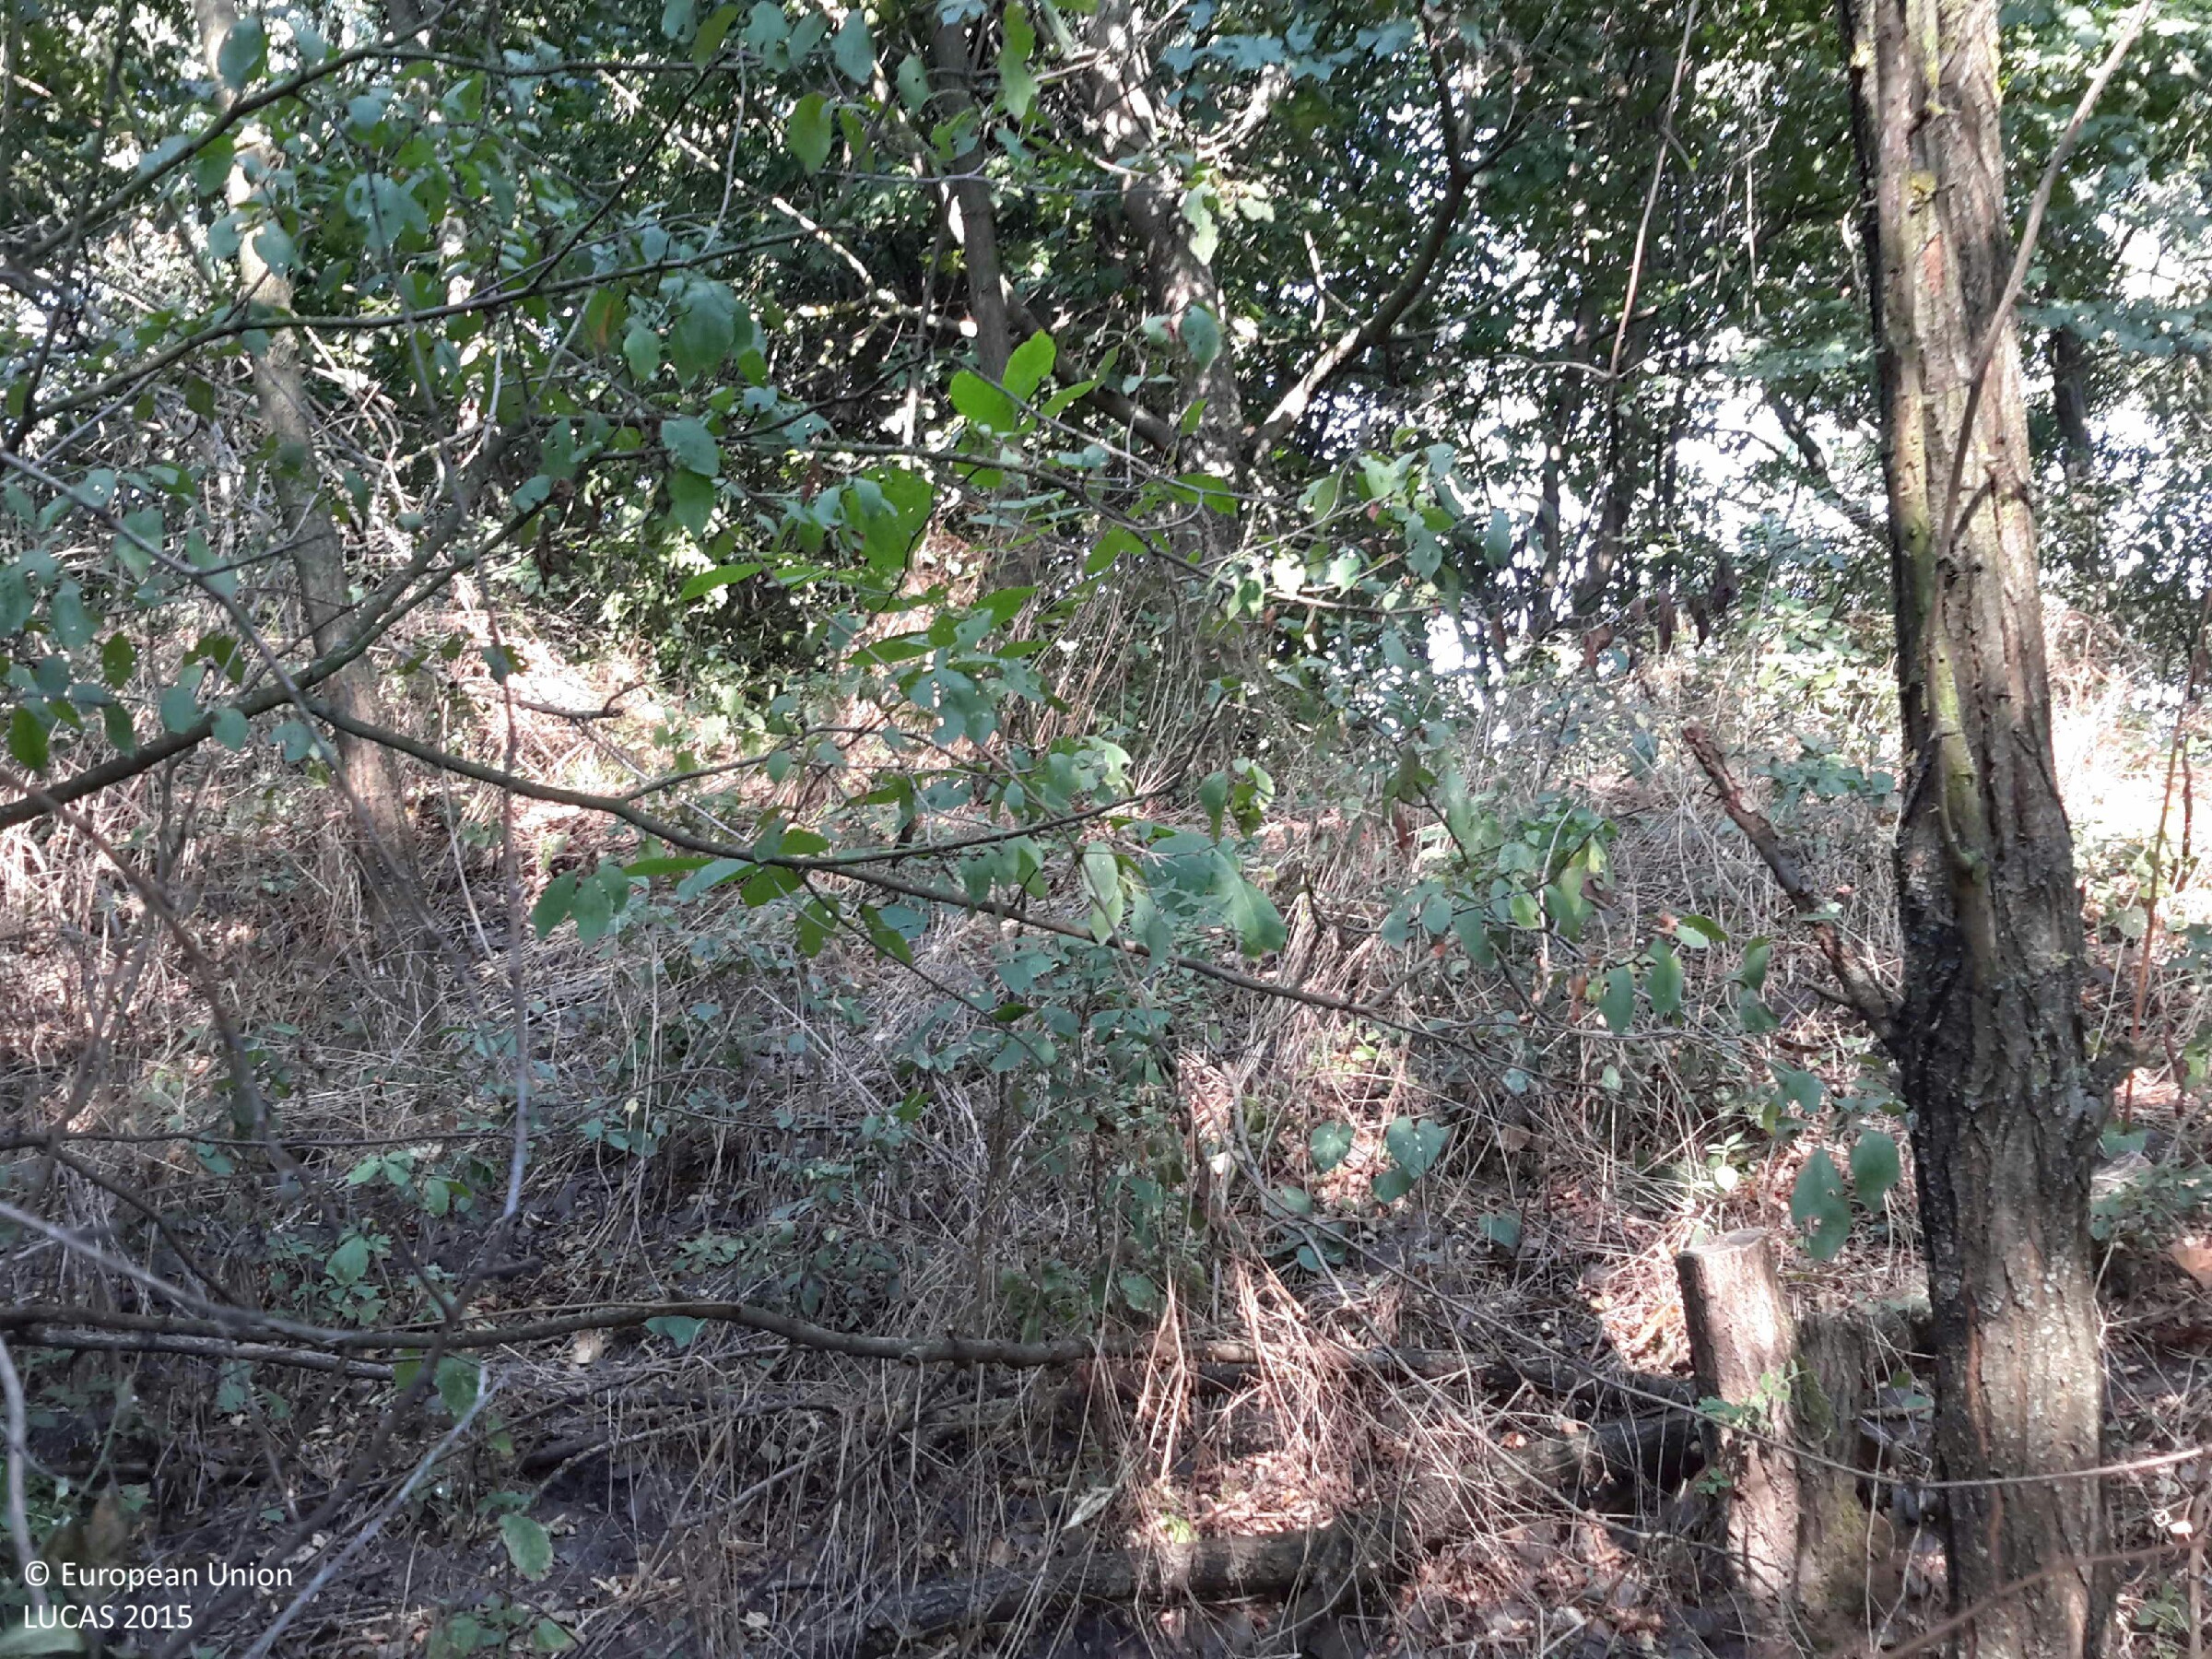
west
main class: Woodland
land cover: Broadleaved woodland
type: mesophytic deciduous forest
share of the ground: > 75 %
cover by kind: broadleaved forest trees 90 %, shrubs 5 %, herbaceous plants 5 %
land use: Forestry
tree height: > 5 m
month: August
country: HU
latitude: 47.9196
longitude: 17.1400
